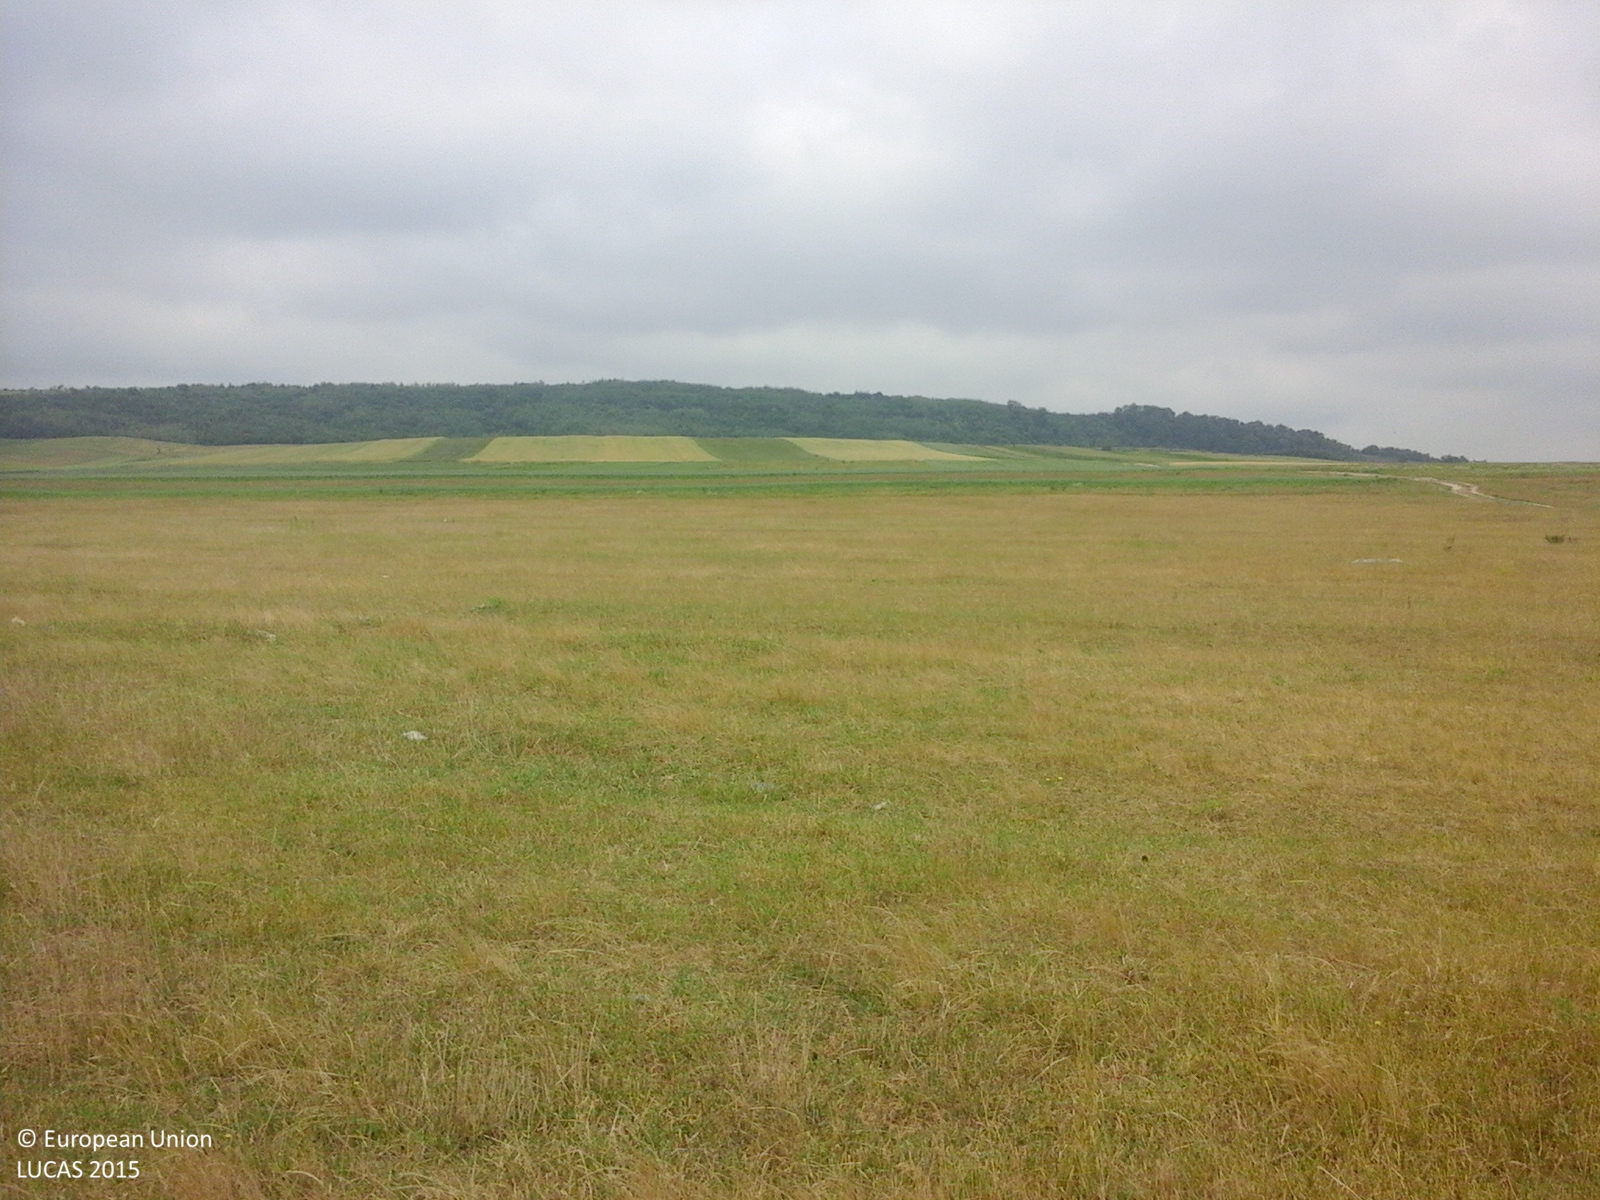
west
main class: Grassland
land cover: Grassland without tree/shrub cover
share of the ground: > 75 %
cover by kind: herbaceous plants 100 %
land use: Agriculture (excluding fallow land and kitchen gardens)
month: June
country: RO
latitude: 47.5427
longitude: 26.4699
